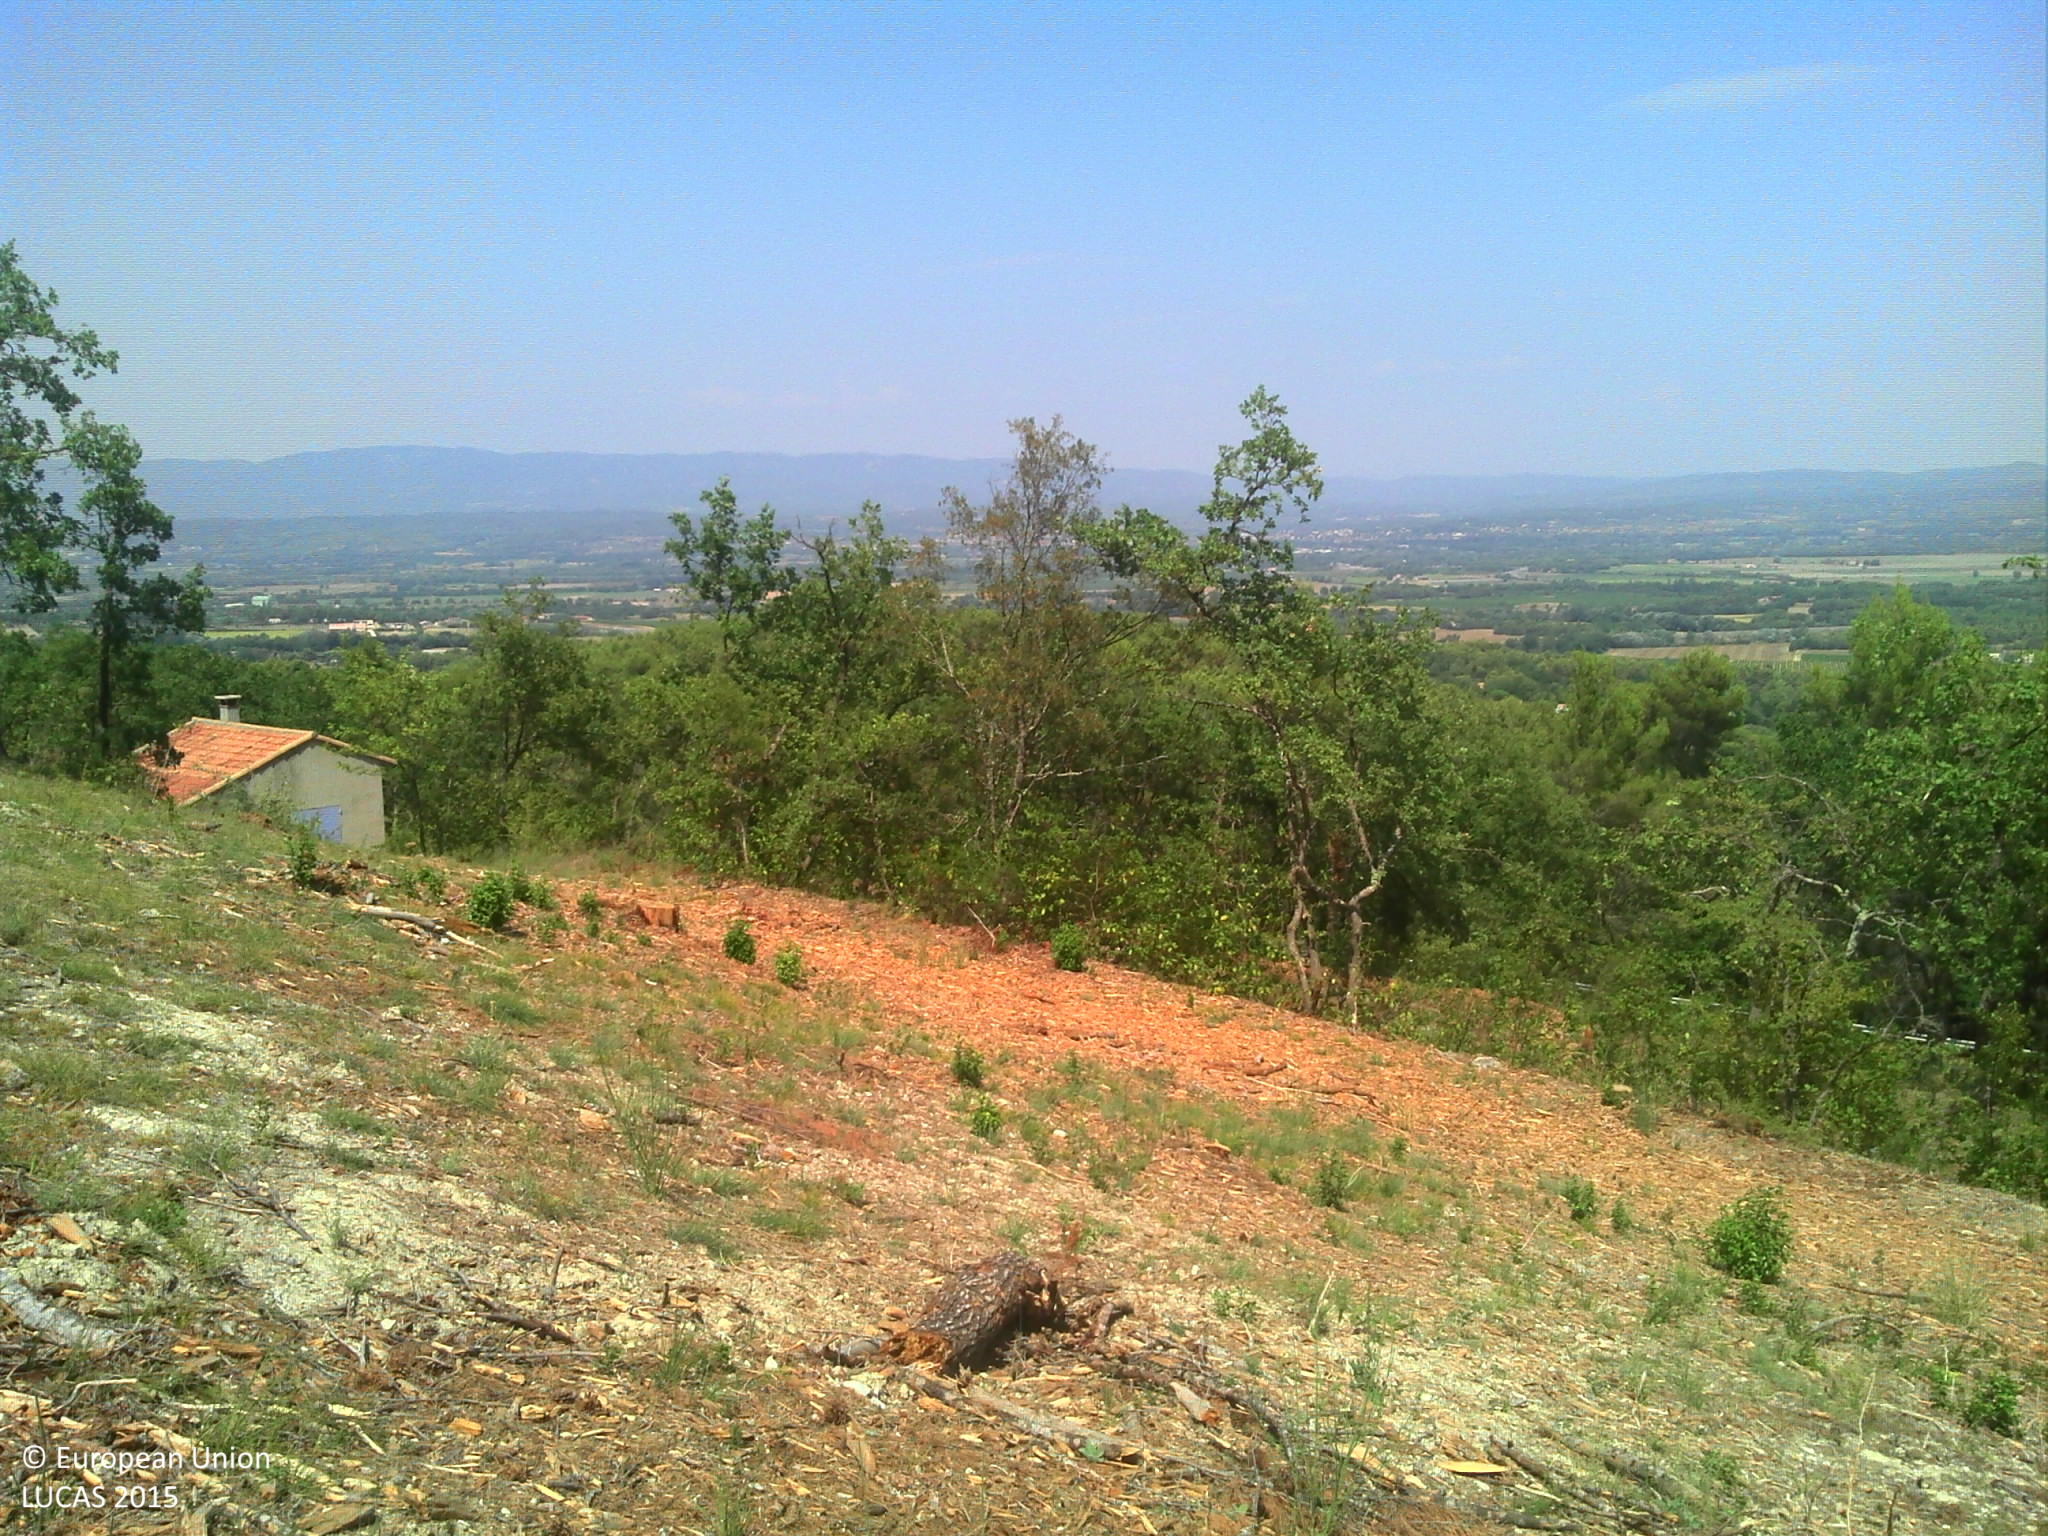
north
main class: Grassland
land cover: Spontaneously vegetated surfaces
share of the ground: 25 - 50 %
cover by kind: unconsolidated bare surface 70 %, herbaceous plants 25 %, shrubs 5 %
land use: Forestry
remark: Clear cut
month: August
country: FR
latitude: 43.6190
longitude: 5.4616
